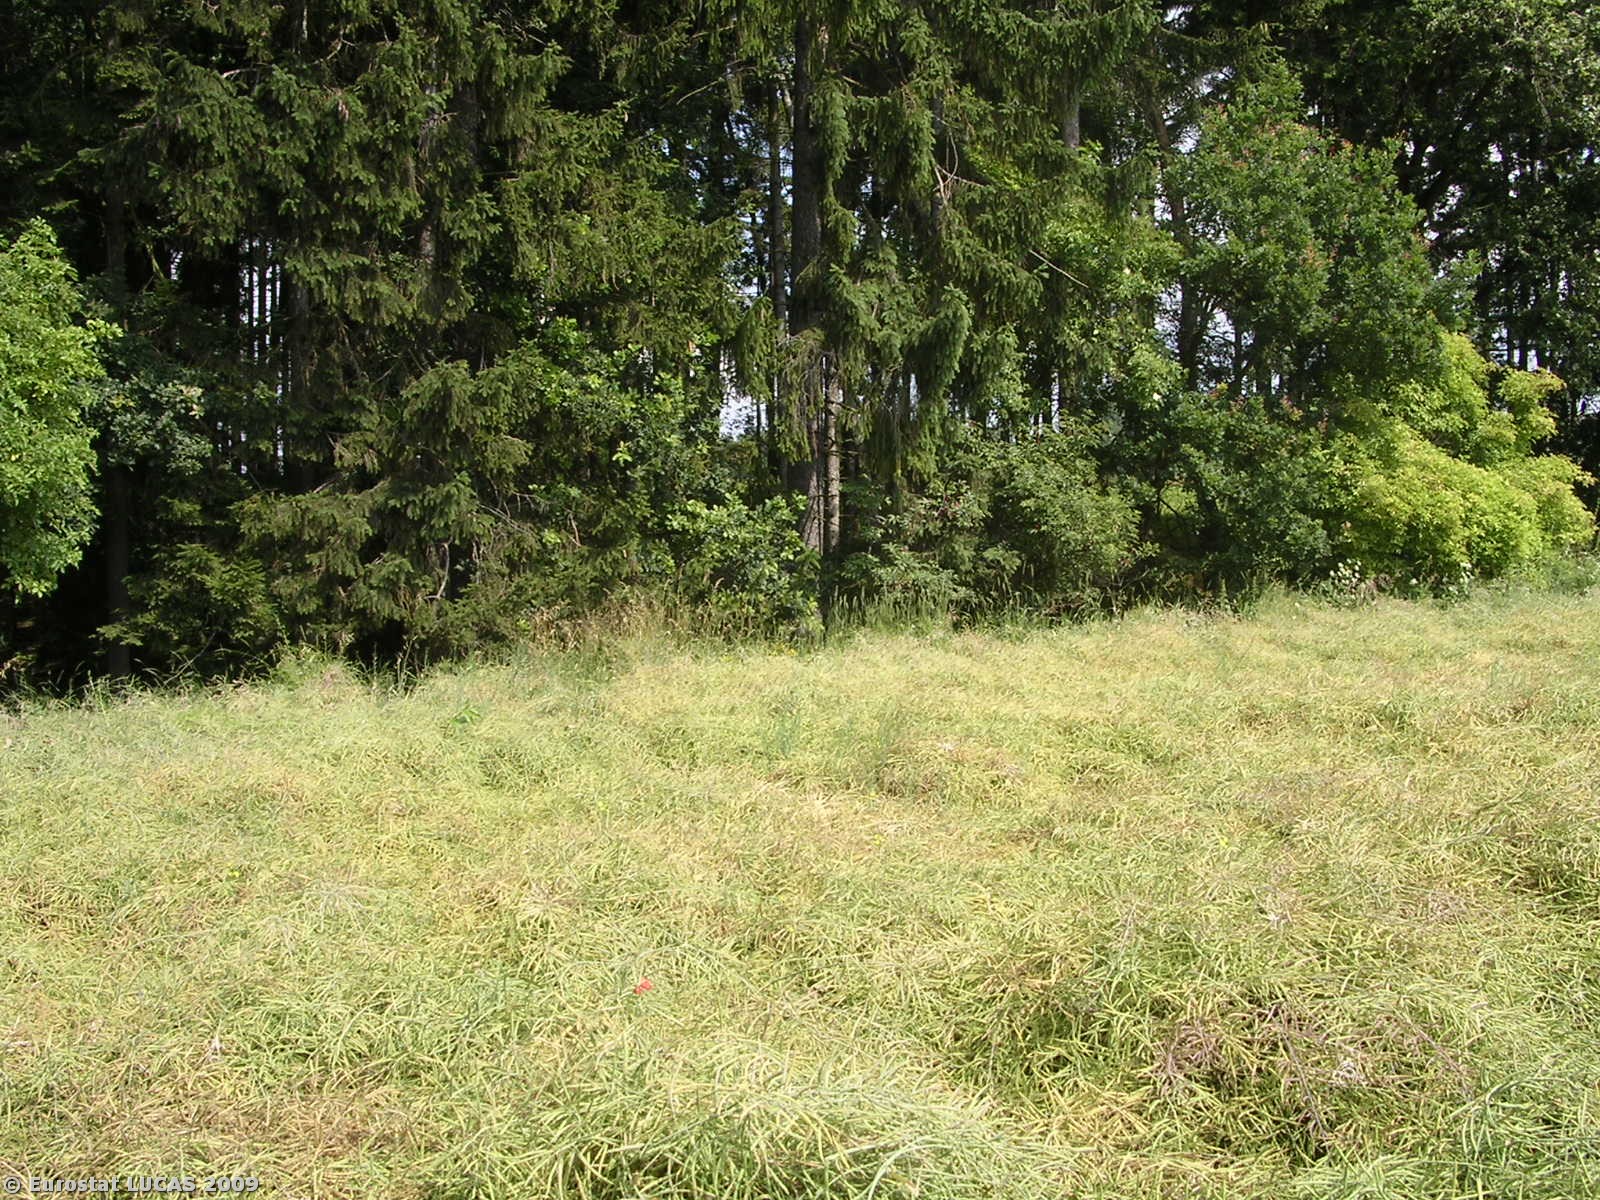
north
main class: Cropland
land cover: Rape and turnip rape
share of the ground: > 75 %
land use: Agriculture (excluding fallow land and kitchen gardens)
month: July
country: CZ
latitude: 50.6130
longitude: 15.0482
